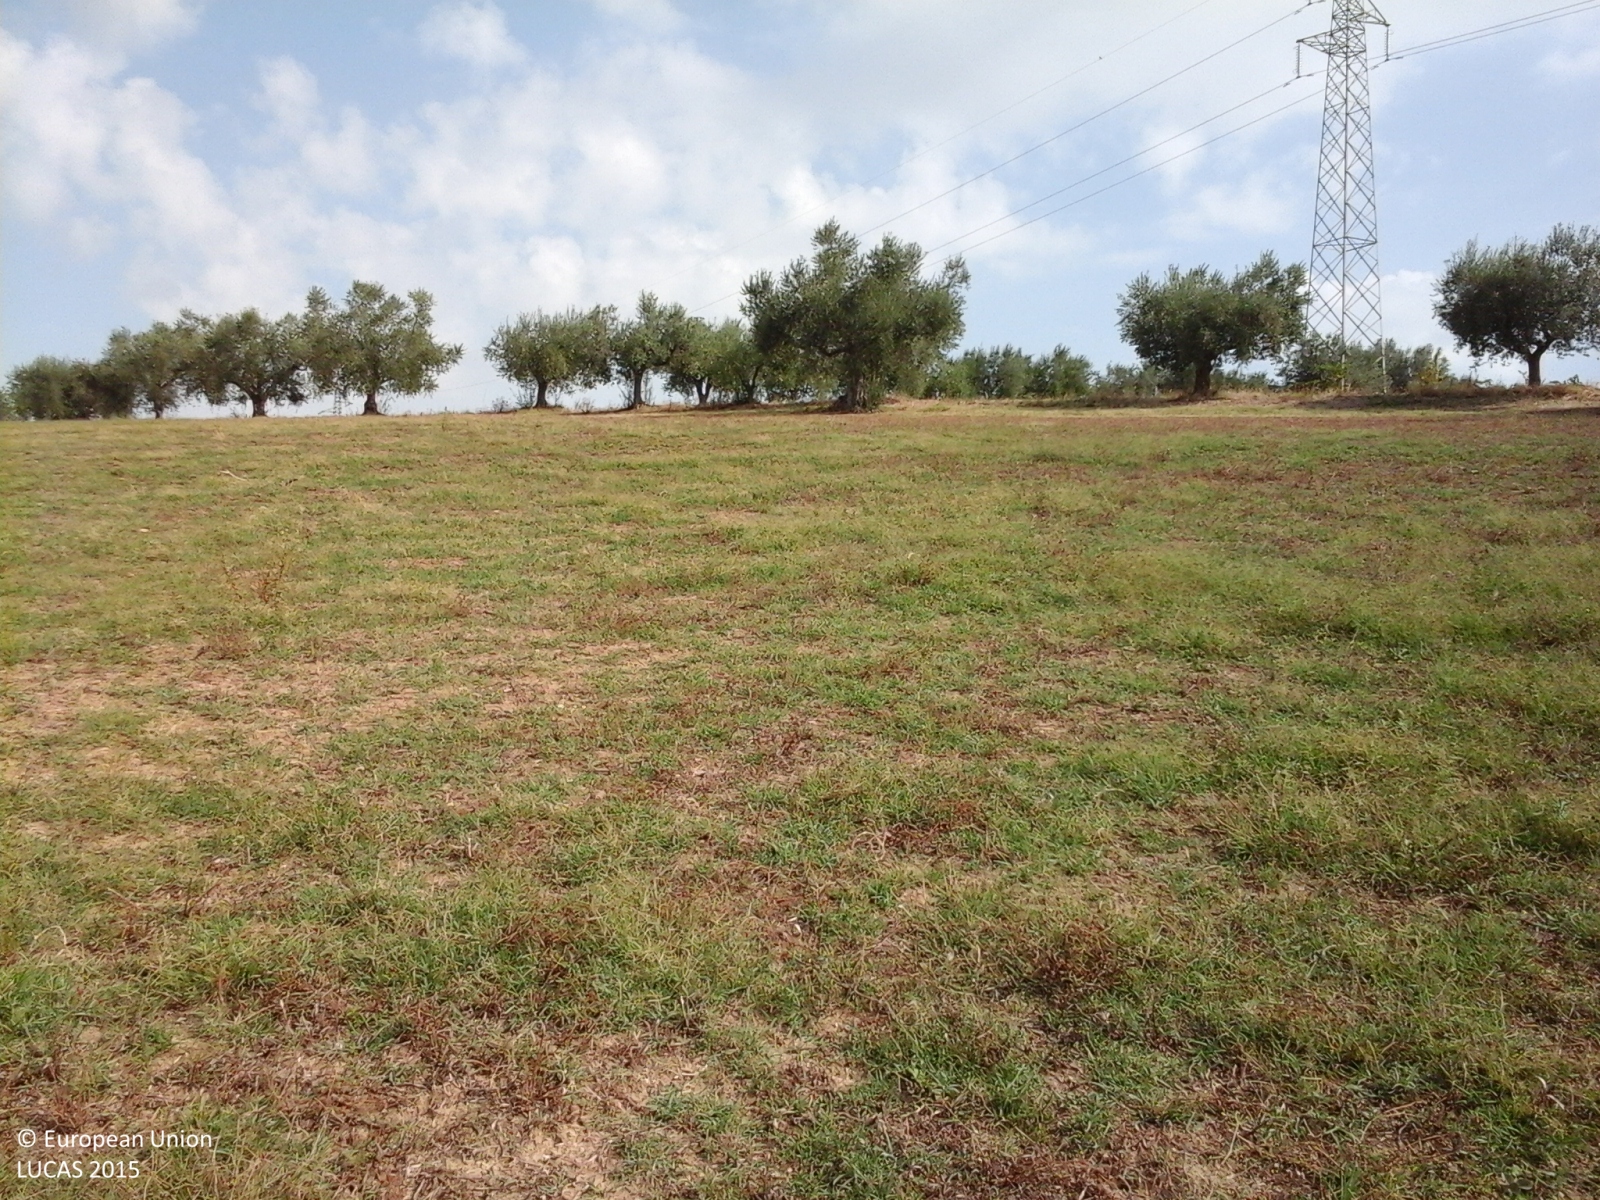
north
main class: Grassland
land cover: Spontaneously vegetated surfaces
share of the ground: > 75 %
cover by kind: herbaceous plants 100 %
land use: Agriculture (excluding fallow land and kitchen gardens)
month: August
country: IT
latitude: 42.7584
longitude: 13.9357
